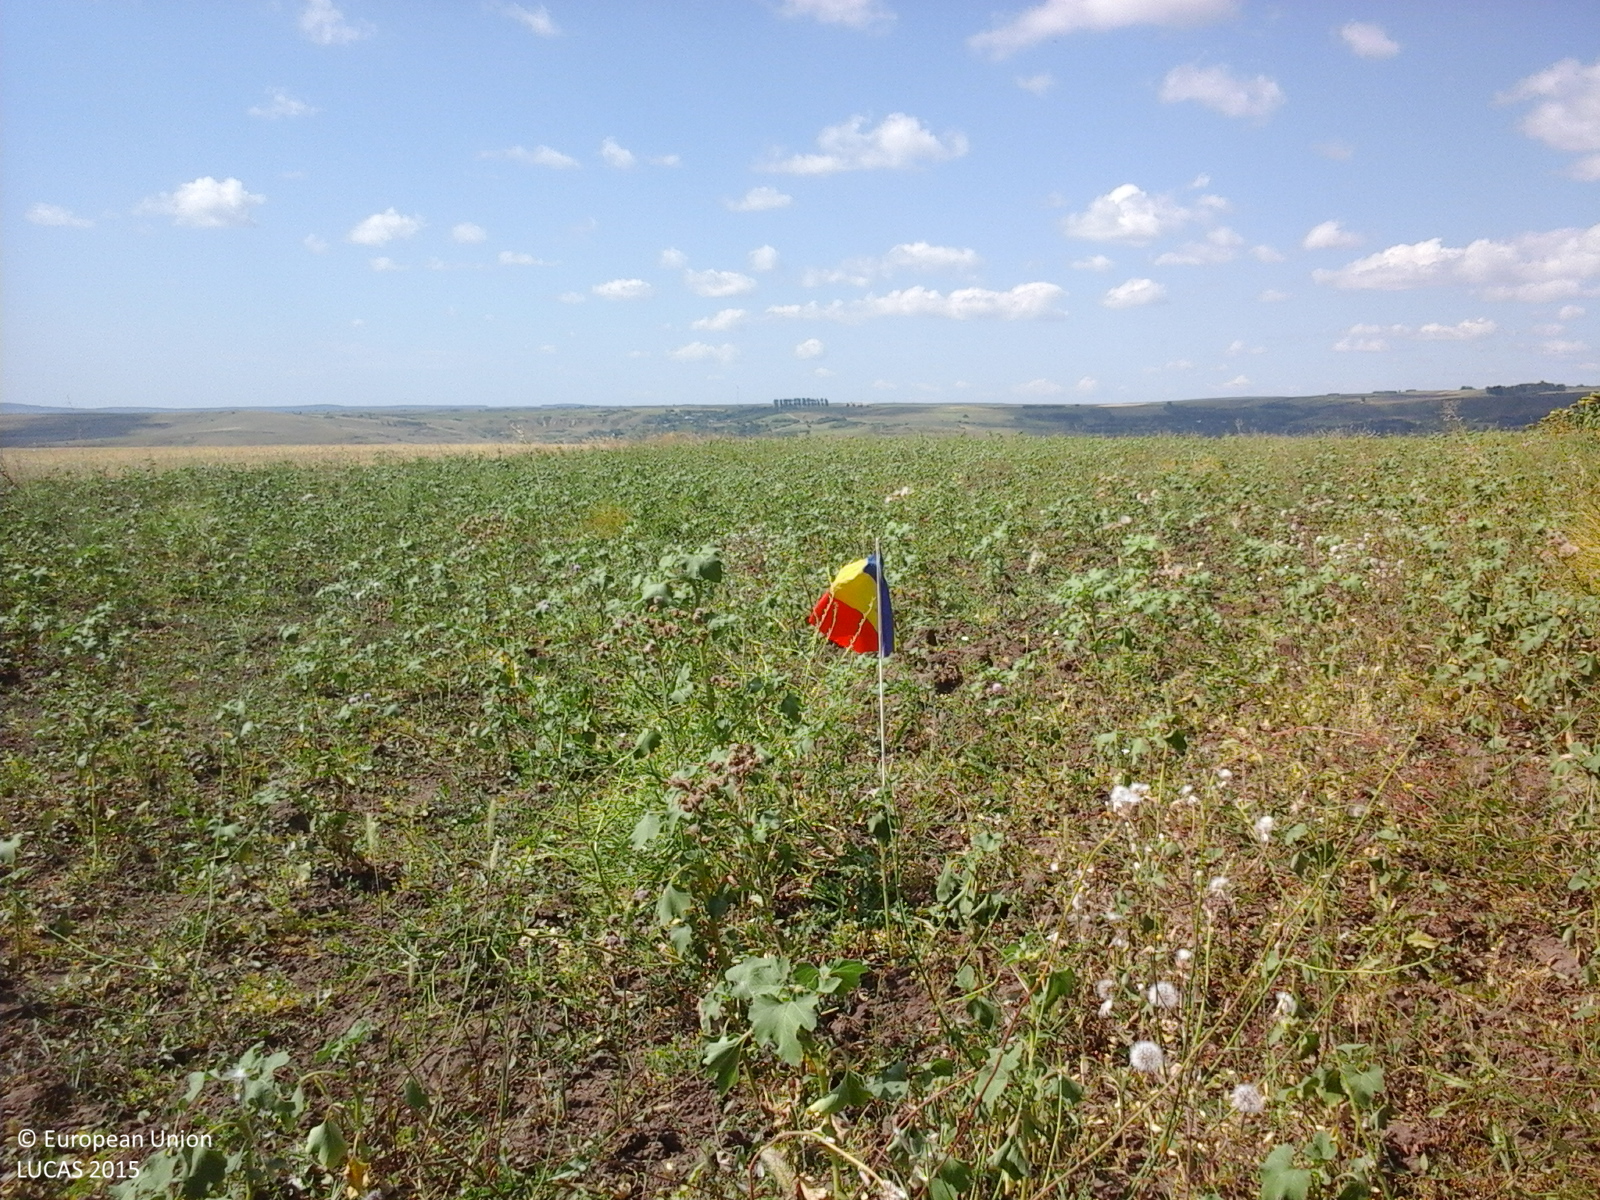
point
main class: Grassland
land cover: Spontaneously vegetated surfaces
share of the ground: > 75 %
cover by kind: herbaceous plants 100 %
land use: Fallow land
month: July
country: RO
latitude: 46.3312
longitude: 27.9323
